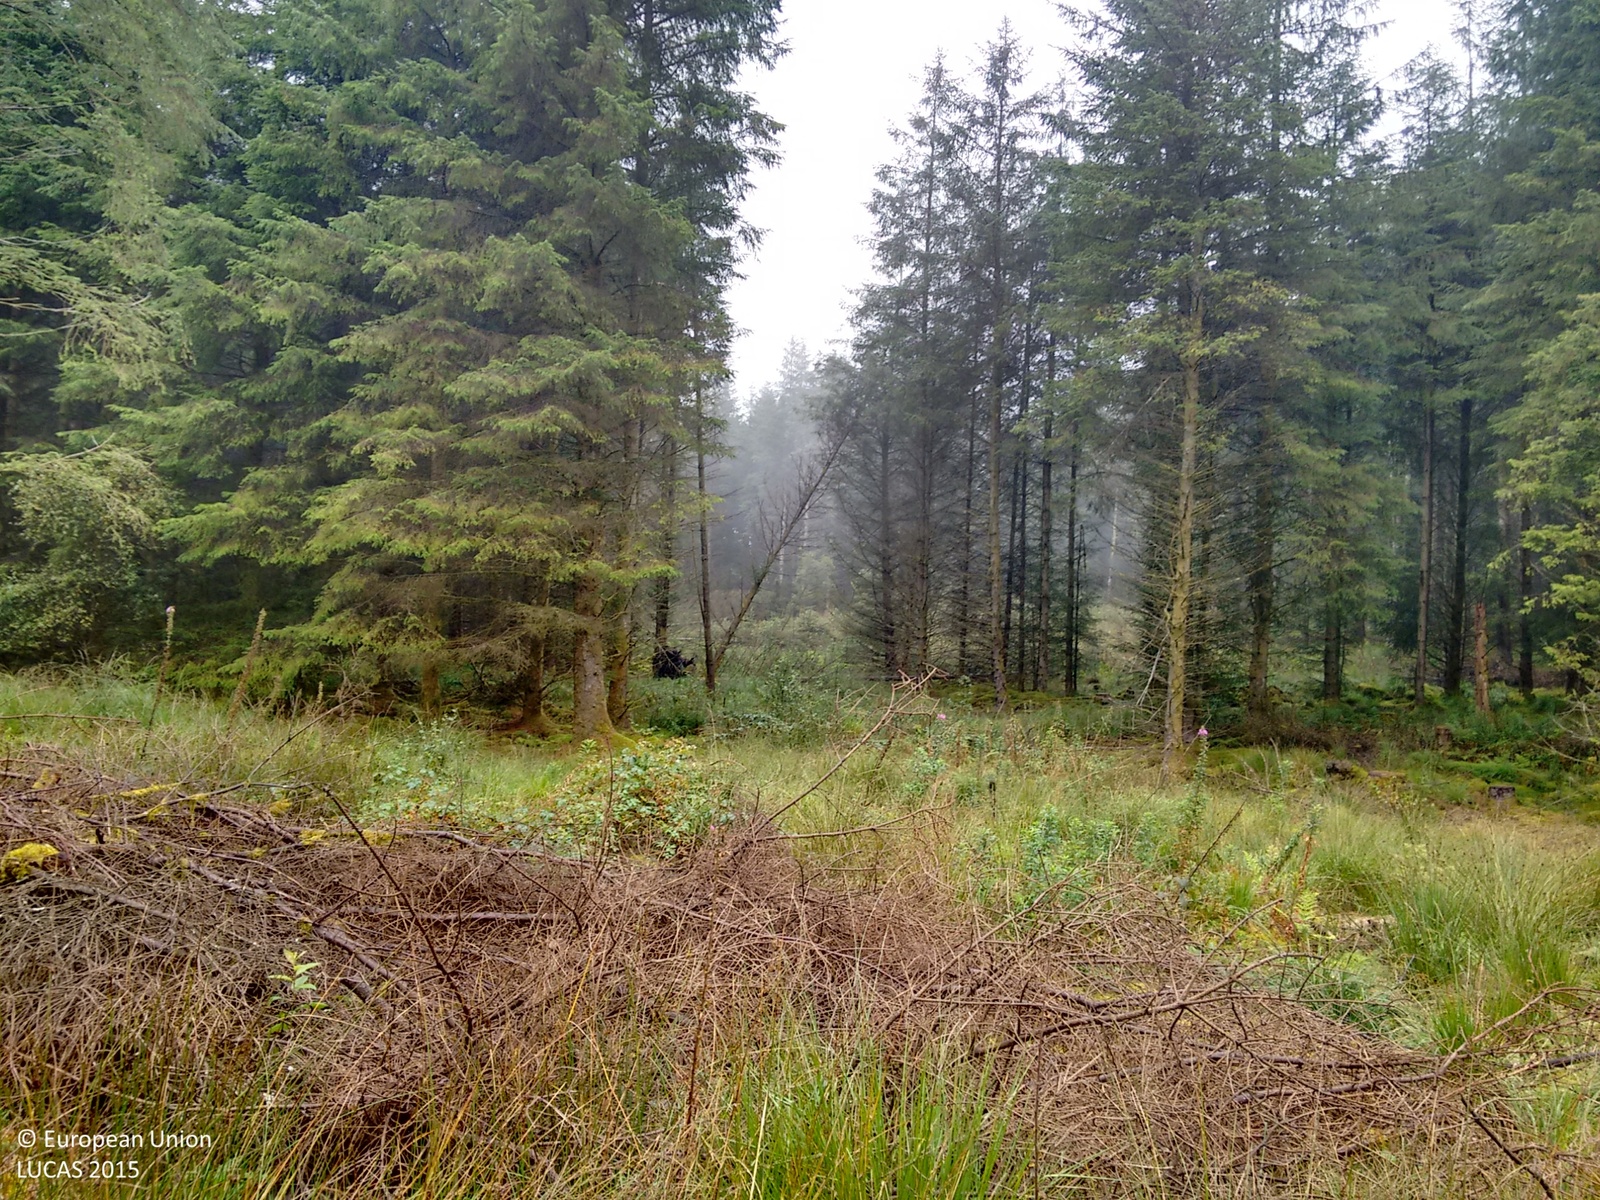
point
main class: Woodland
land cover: Spruce dominated coniferous woodland
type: exotic forest
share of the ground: > 75 %
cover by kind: coniferous forest trees 70 %, shrubs 15 %, herbaceous plants 15 %
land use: Forestry
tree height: > 5 m
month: September
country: GB
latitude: 52.1277
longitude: -3.8369
